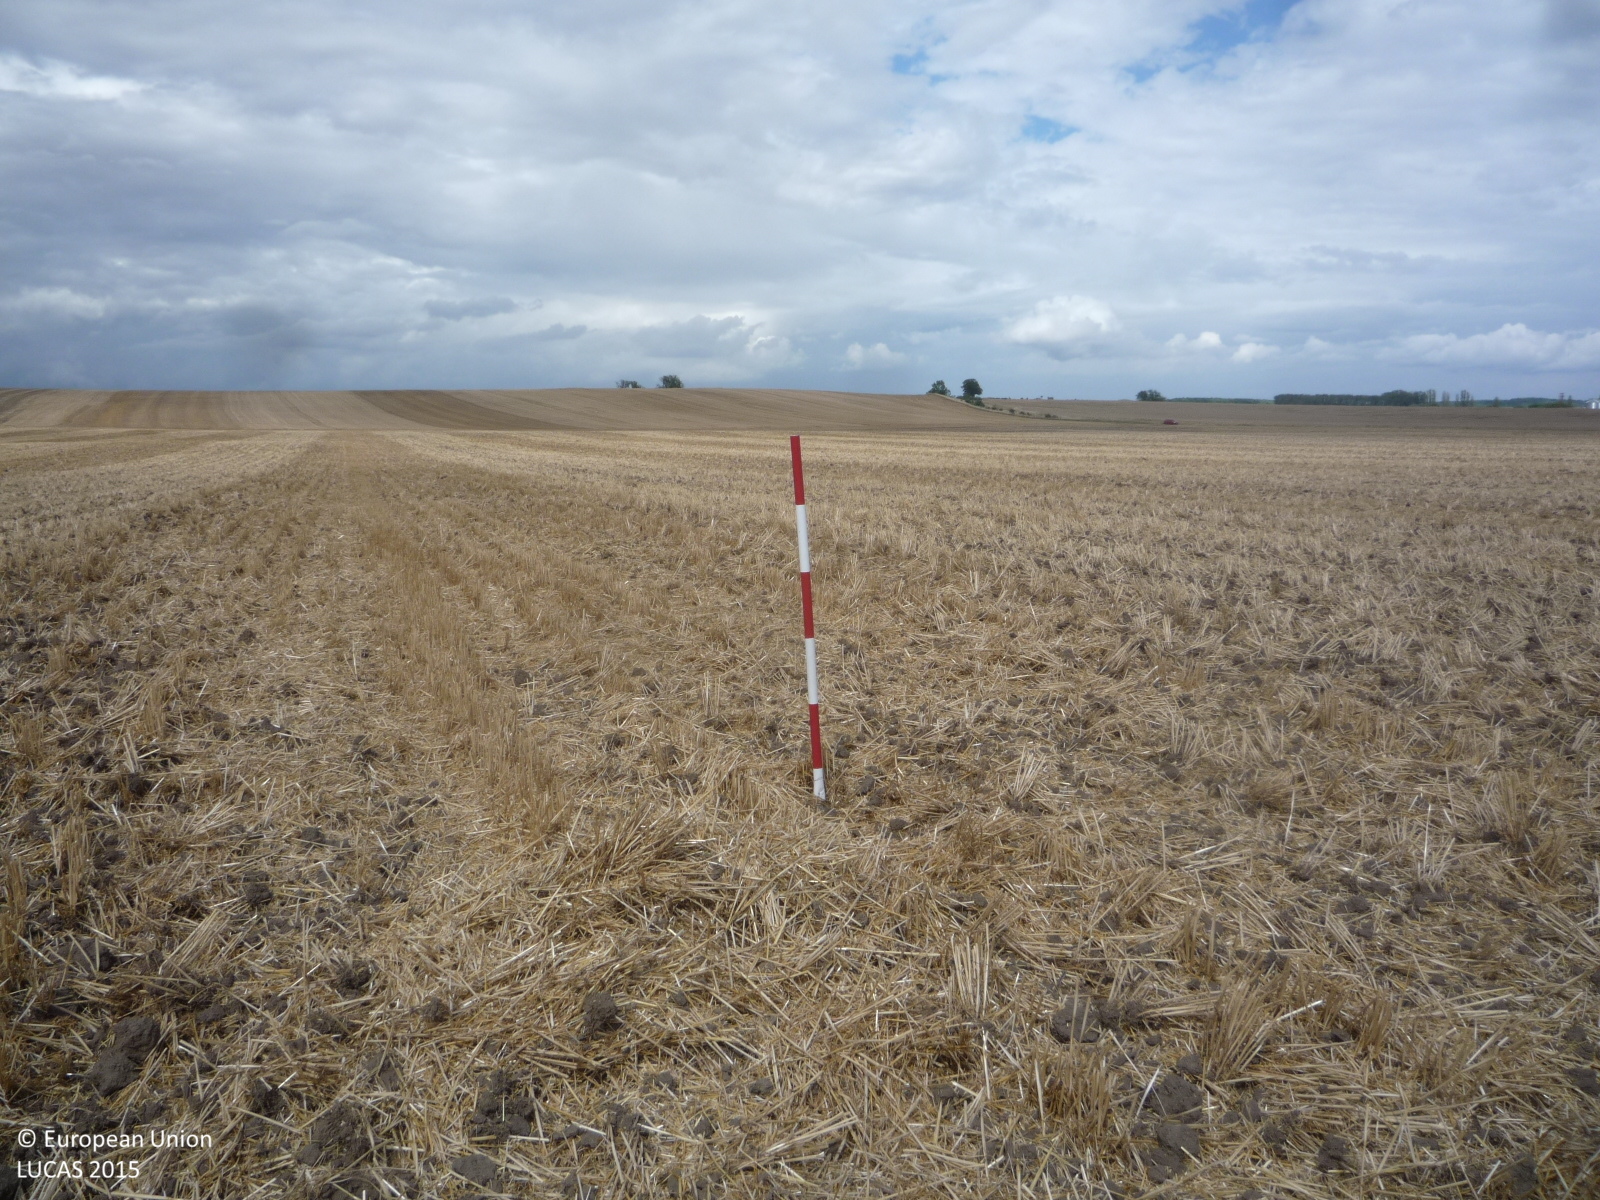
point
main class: Cropland
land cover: Common wheat
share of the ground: > 75 %
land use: Agriculture (excluding fallow land and kitchen gardens)
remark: Tilled/Sowed
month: July
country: CZ
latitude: 50.3147
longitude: 15.2697
